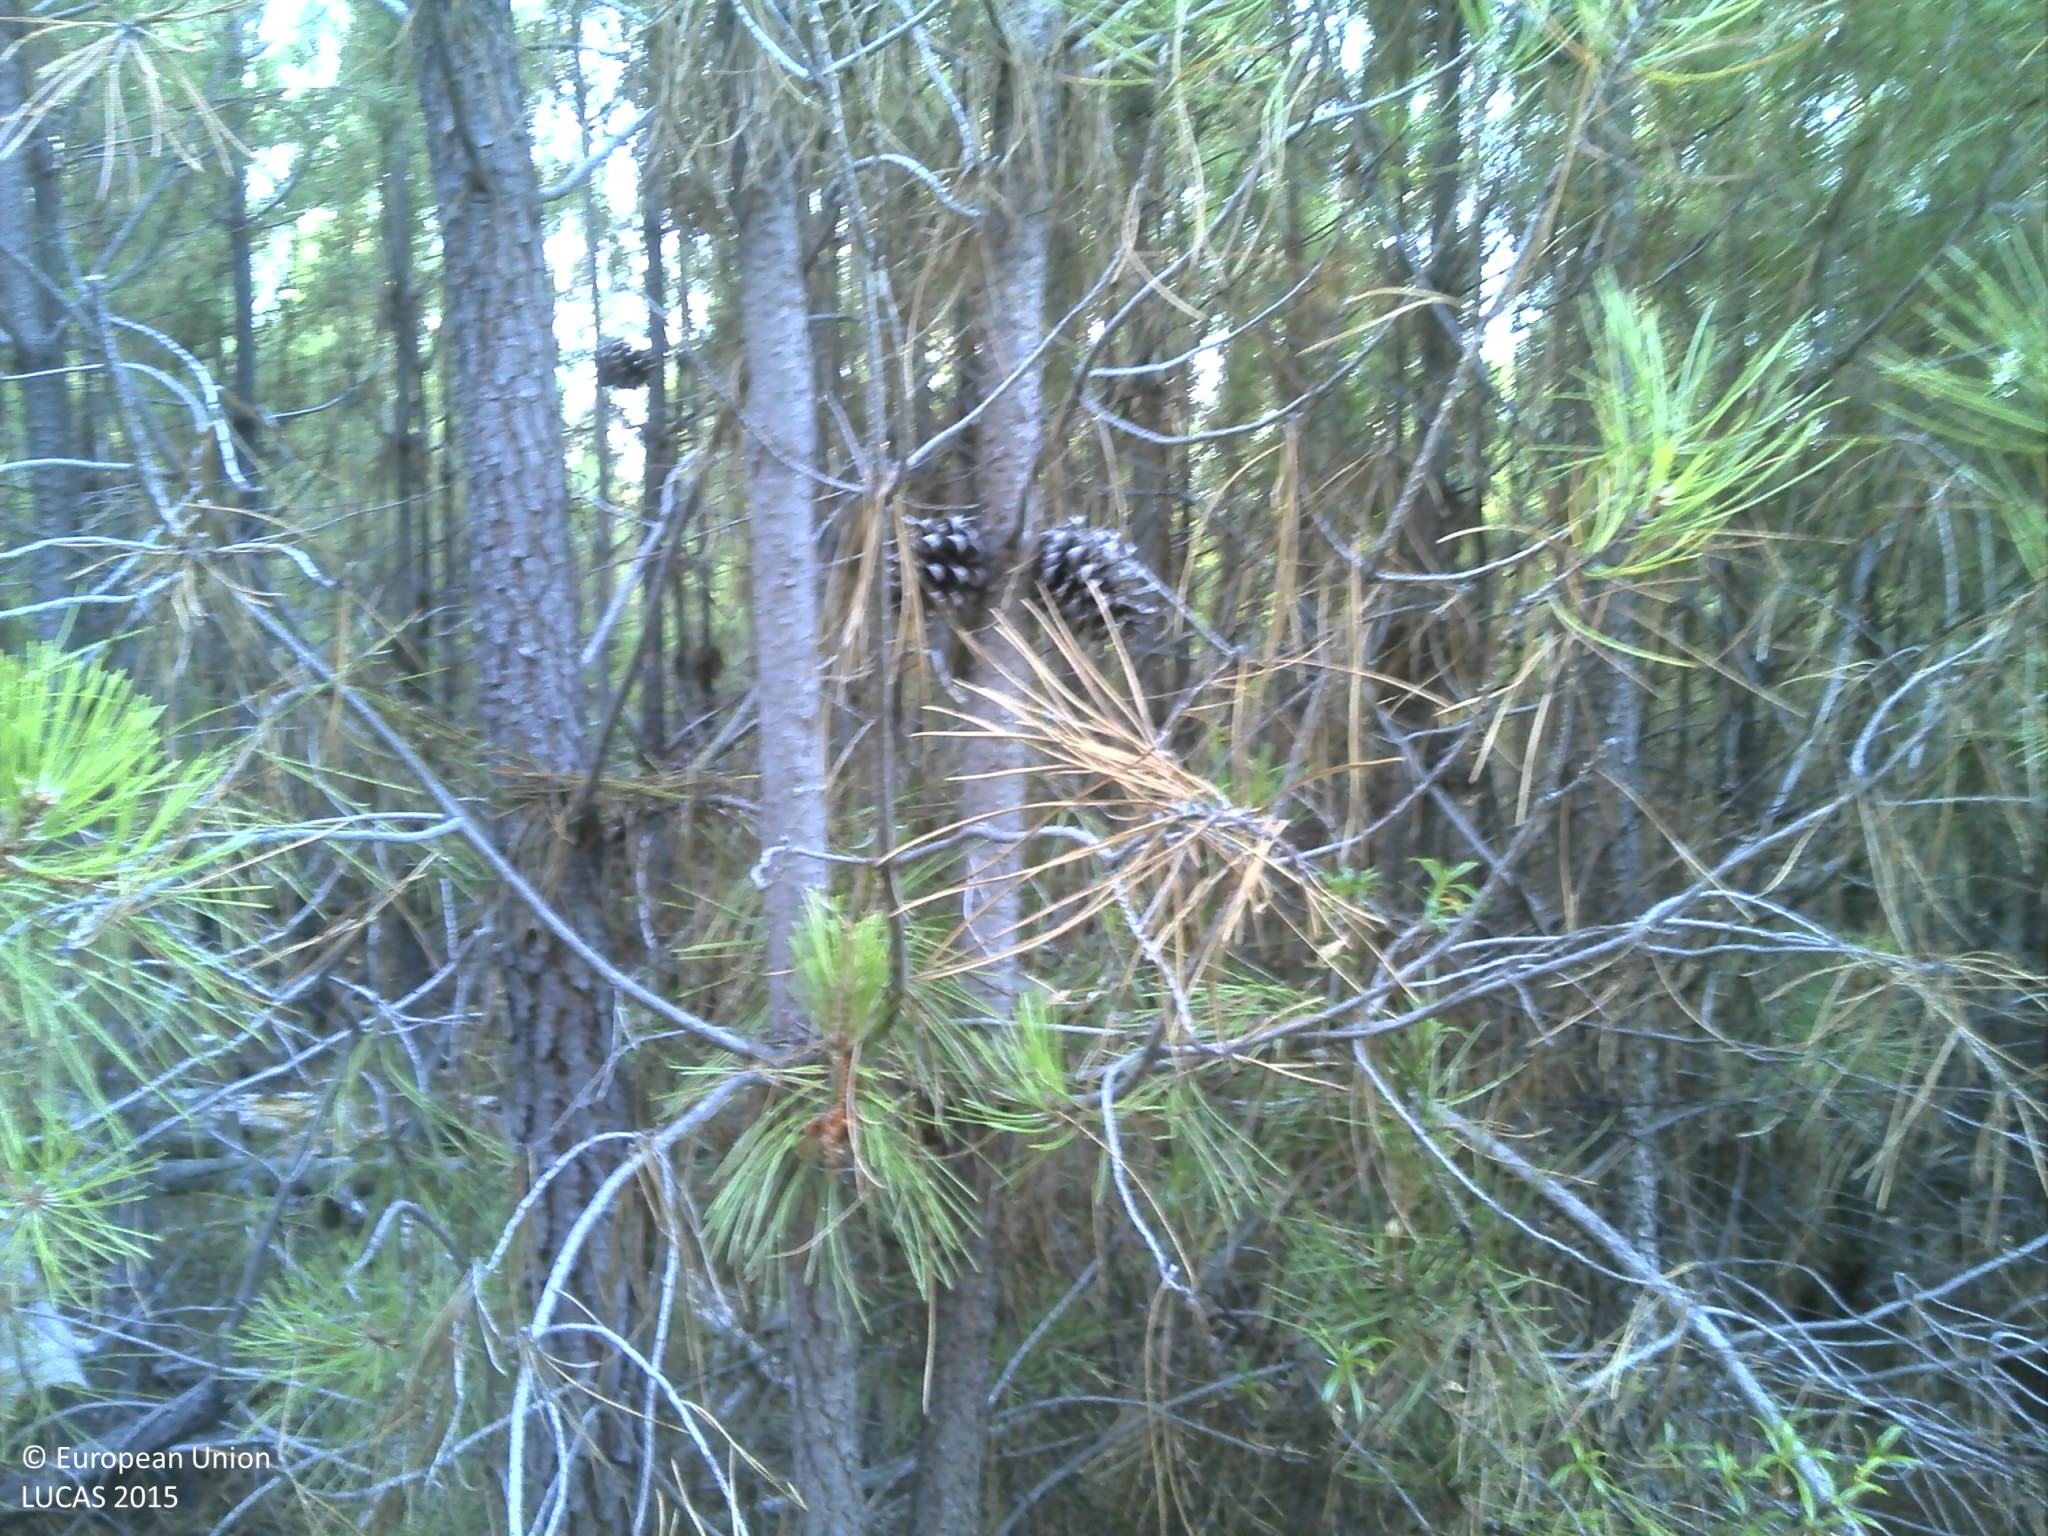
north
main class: Woodland
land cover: Pine dominated coniferous woodland
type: coniferous forest of the mediterranean region
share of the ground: 50 - 75 %
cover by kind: coniferous forest trees 65 %, shrubs 25 %, unconsolidated bare surface 5 %
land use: Forestry
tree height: > 5 m
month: July
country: PT
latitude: 39.9203
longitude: -7.7863
